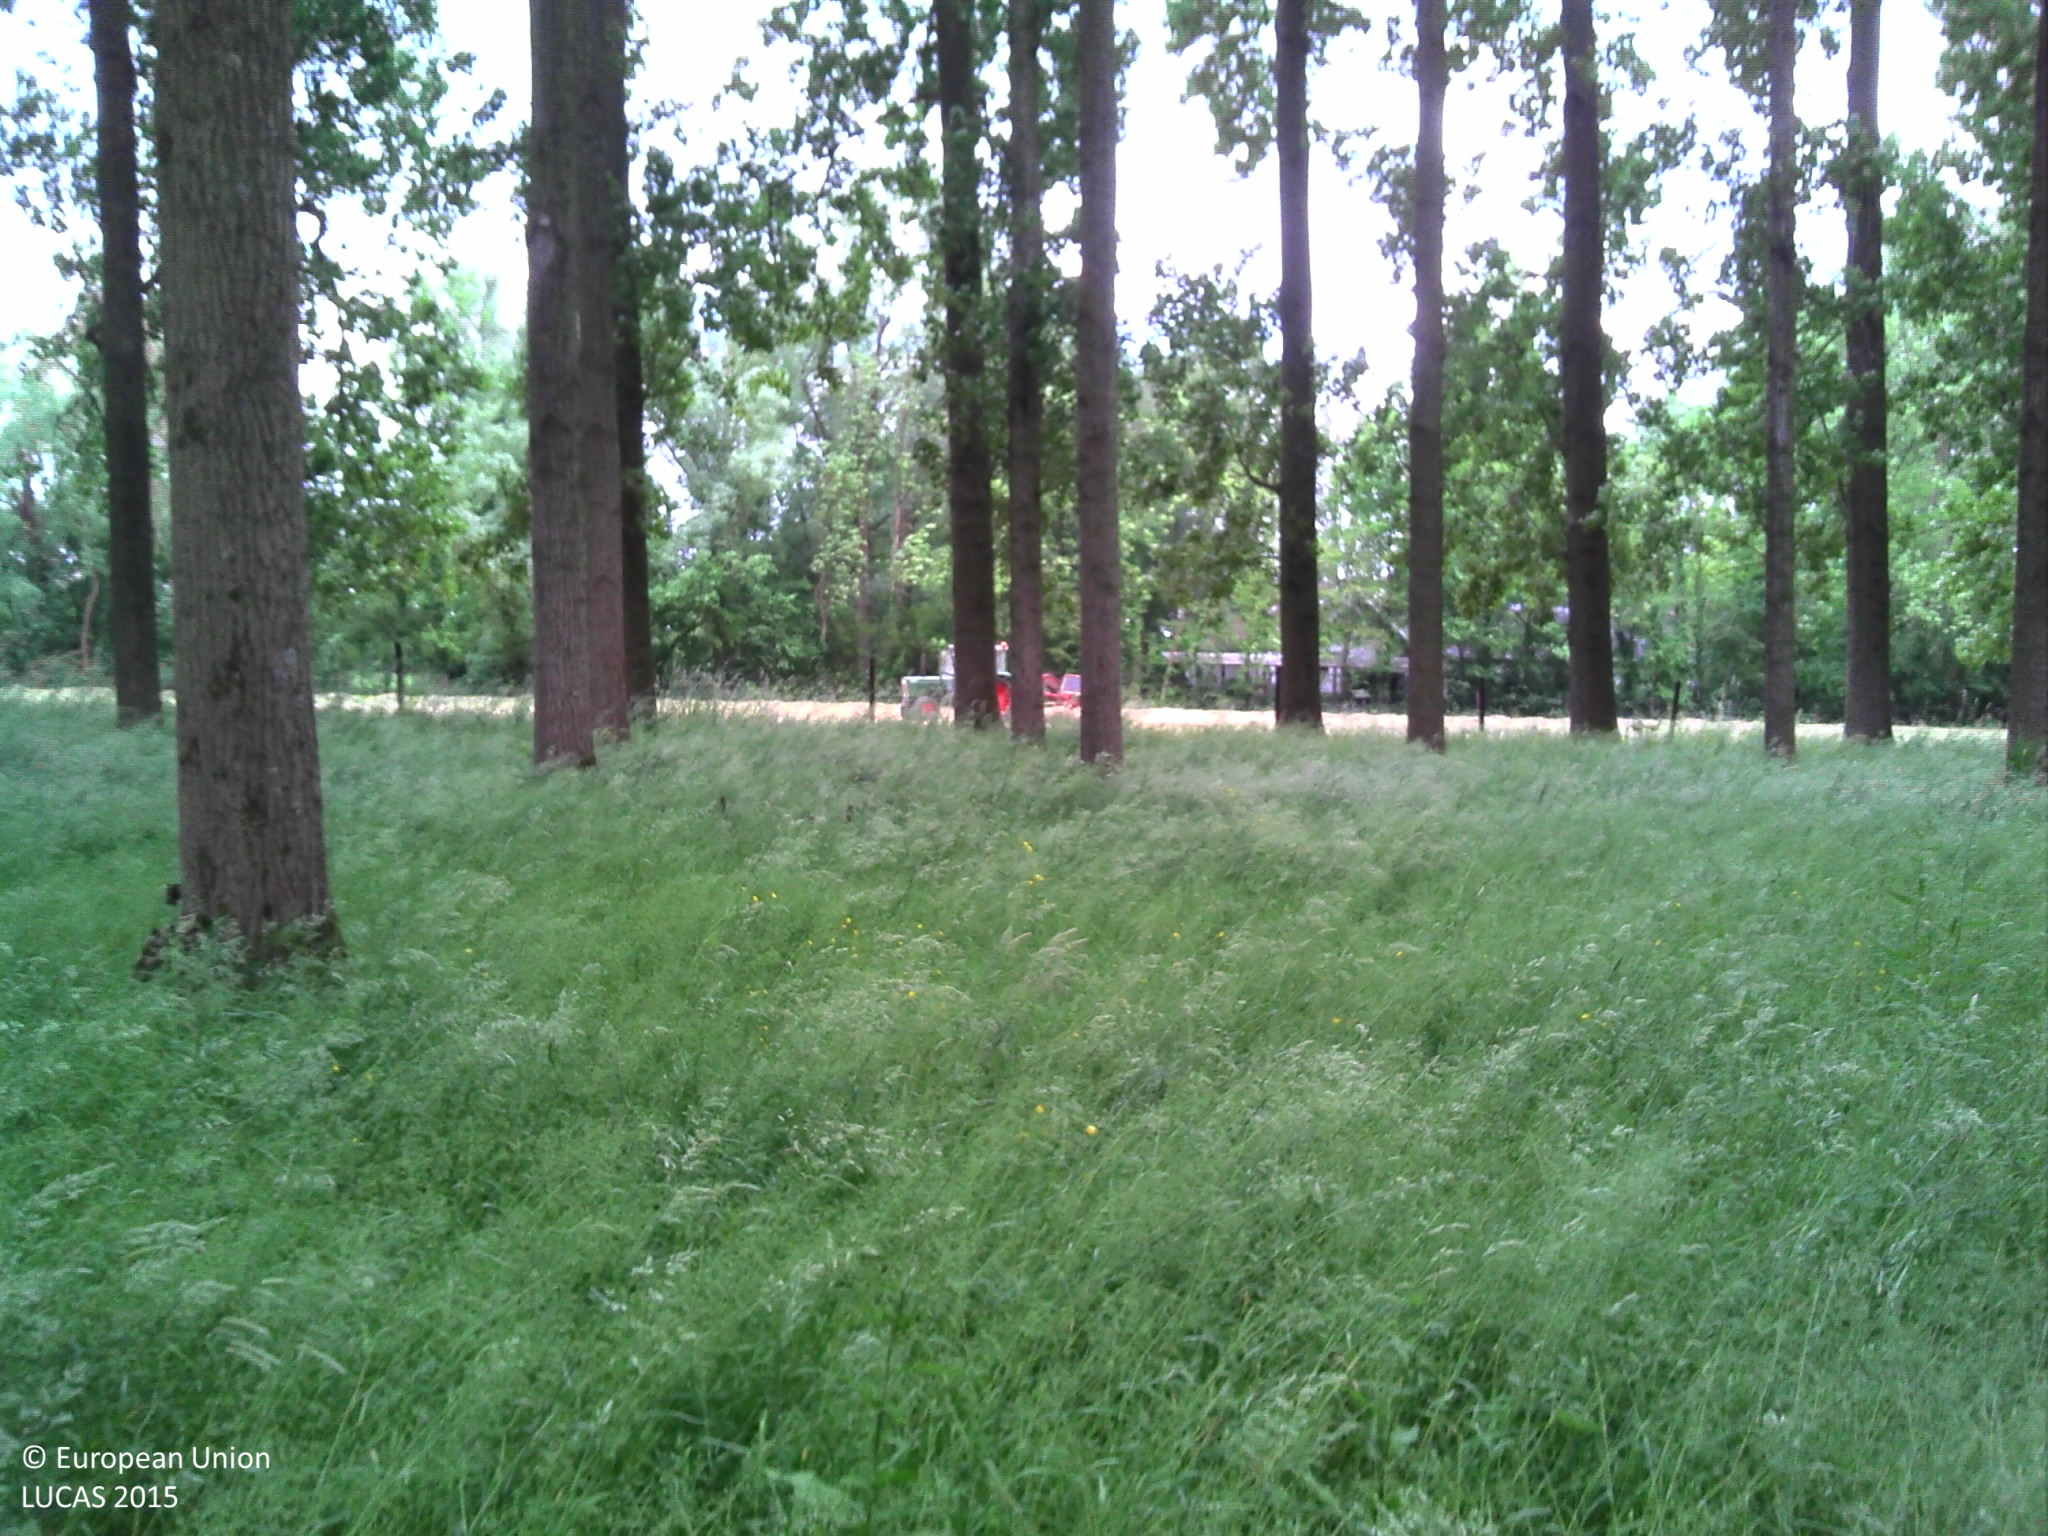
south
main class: Woodland
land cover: Broadleaved woodland
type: exotic forest
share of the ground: > 75 %
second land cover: Grassland without tree/shrub cover
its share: > 75 %
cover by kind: broadleaved forest trees 75 %, herbaceous plants 25 %
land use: Forestry
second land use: Agriculture (excluding fallow land and kitchen gardens)
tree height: > 5 m
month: June
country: BE
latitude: 50.9817
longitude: 3.9974
